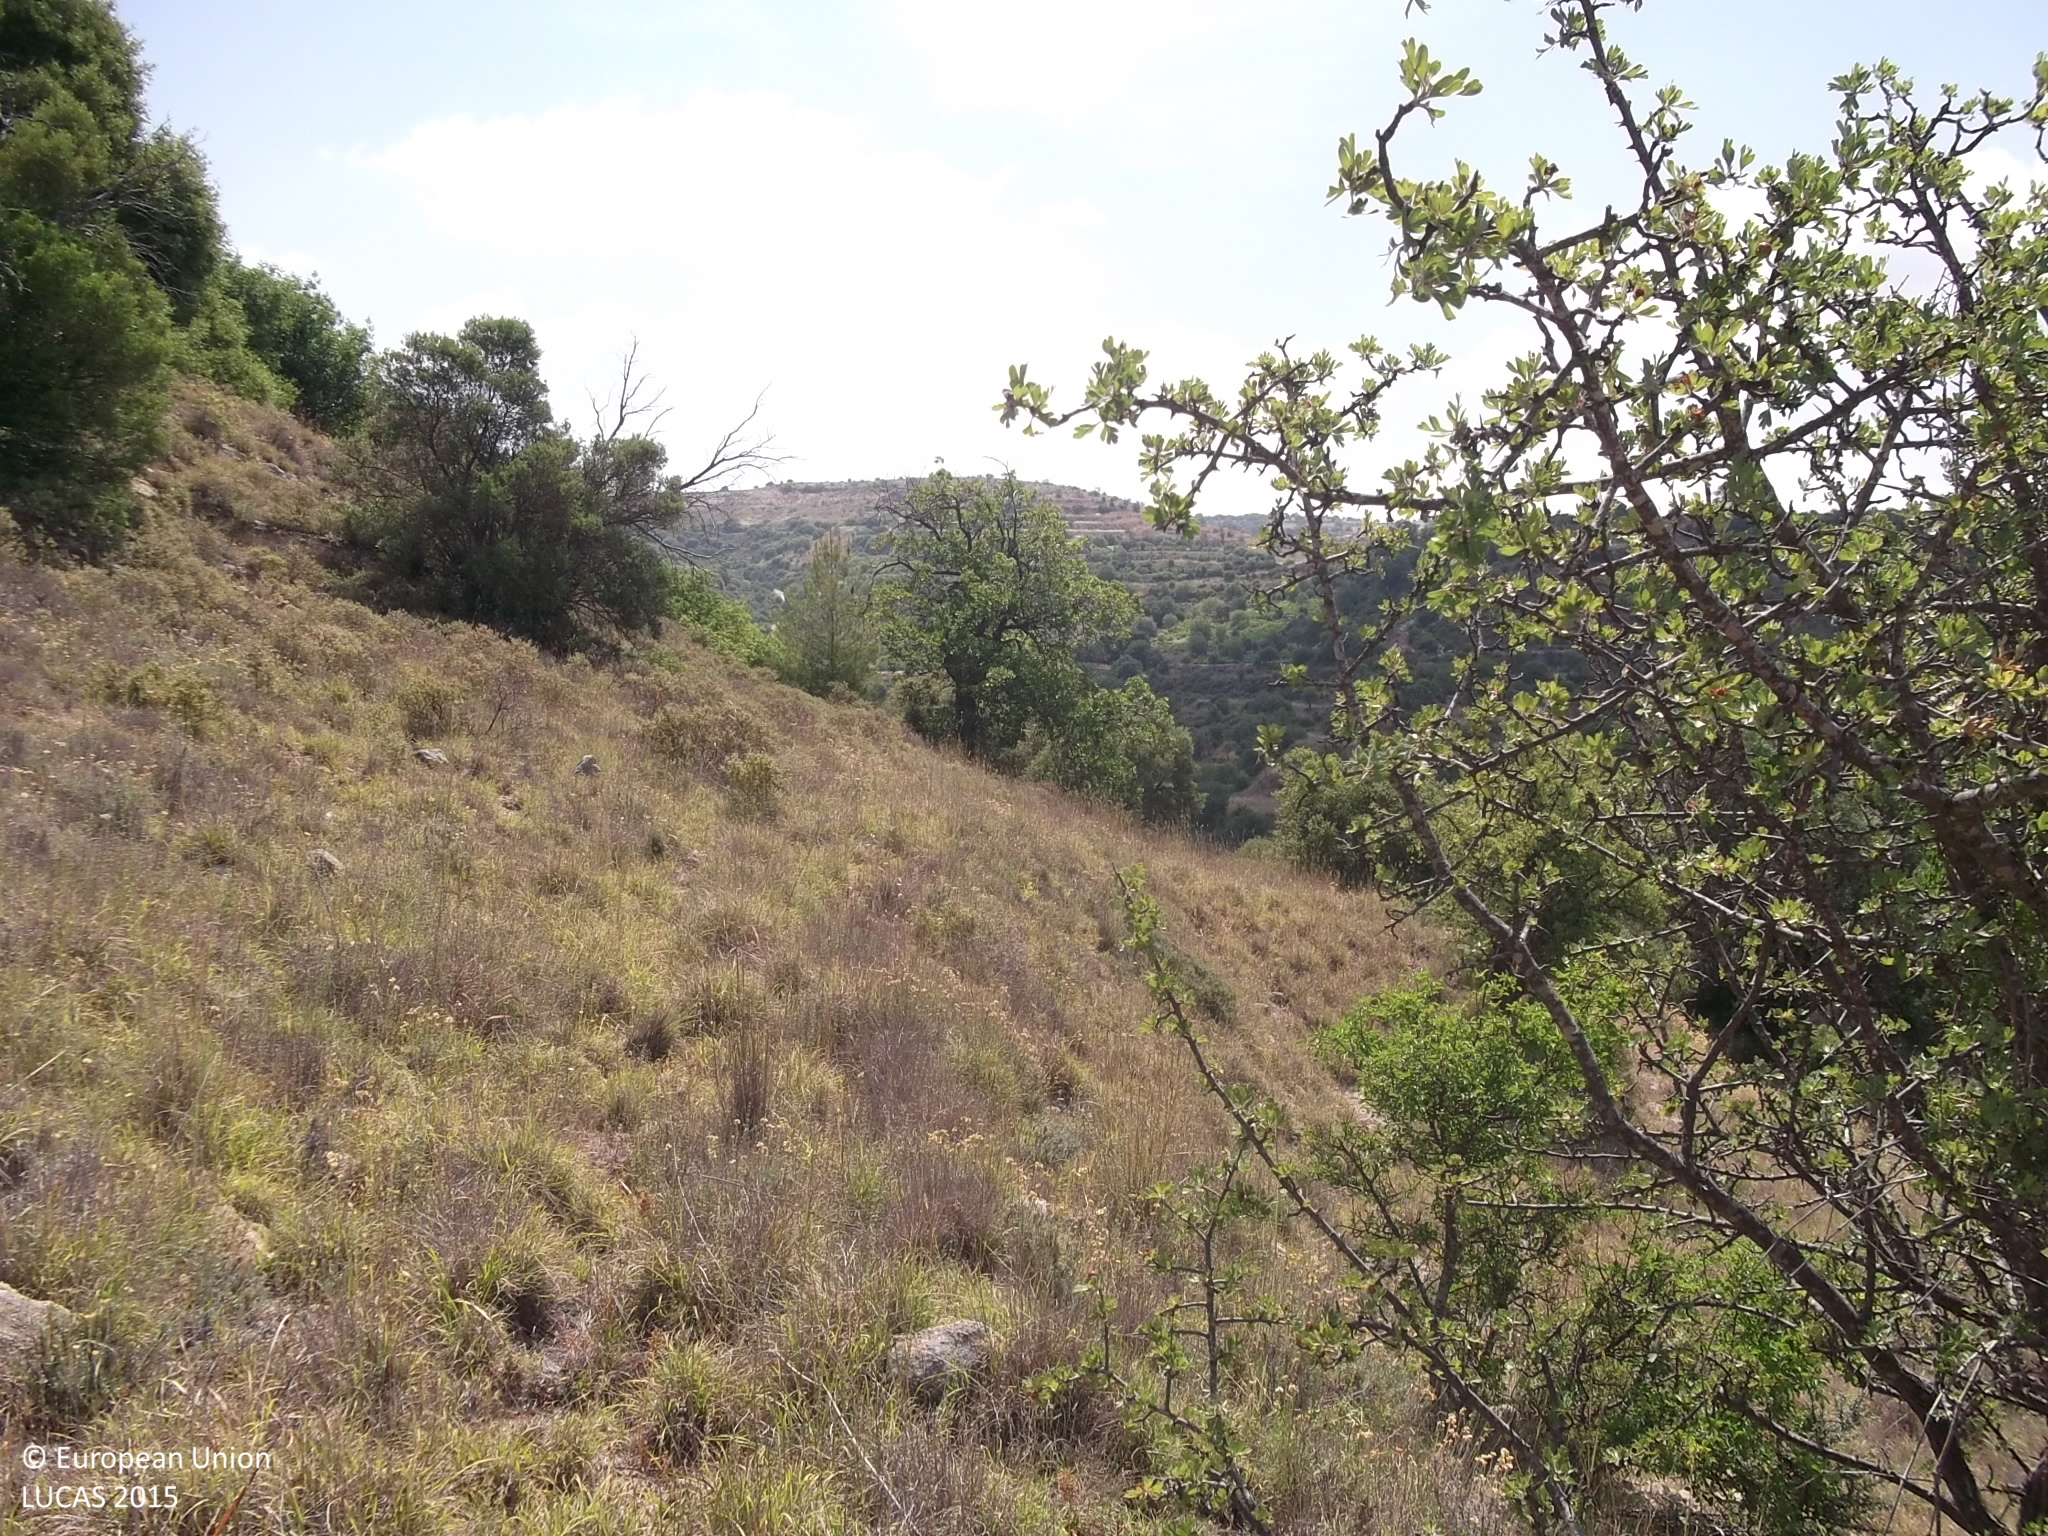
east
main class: Shrubland
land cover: Shrubland with sparse tree cover
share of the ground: > 75 %
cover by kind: shrubs 60 %, herbaceous plants 30 %, broadleaved forest trees 5 %, unconsolidated bare surface 5 %
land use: Semi-natural and natural areas not in use
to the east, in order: Shrubland with sparse tree cover; Dry stone walls; Spontaneously vegetated surfaces; Shrubland with sparse tree cover; Dry stone walls; Shrubland with sparse tree cover; Other bare soil; Dry stone walls; Shrubland with sparse tree cover; Other bare soil; Shrubland without tree cover; Other bare soil; Broadleaved woodland; Other bare soil; Shrubland without tree cover; Tracks; Rock outcrops; Olive groves
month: May
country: CY
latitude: 34.8661
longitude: 32.5669
